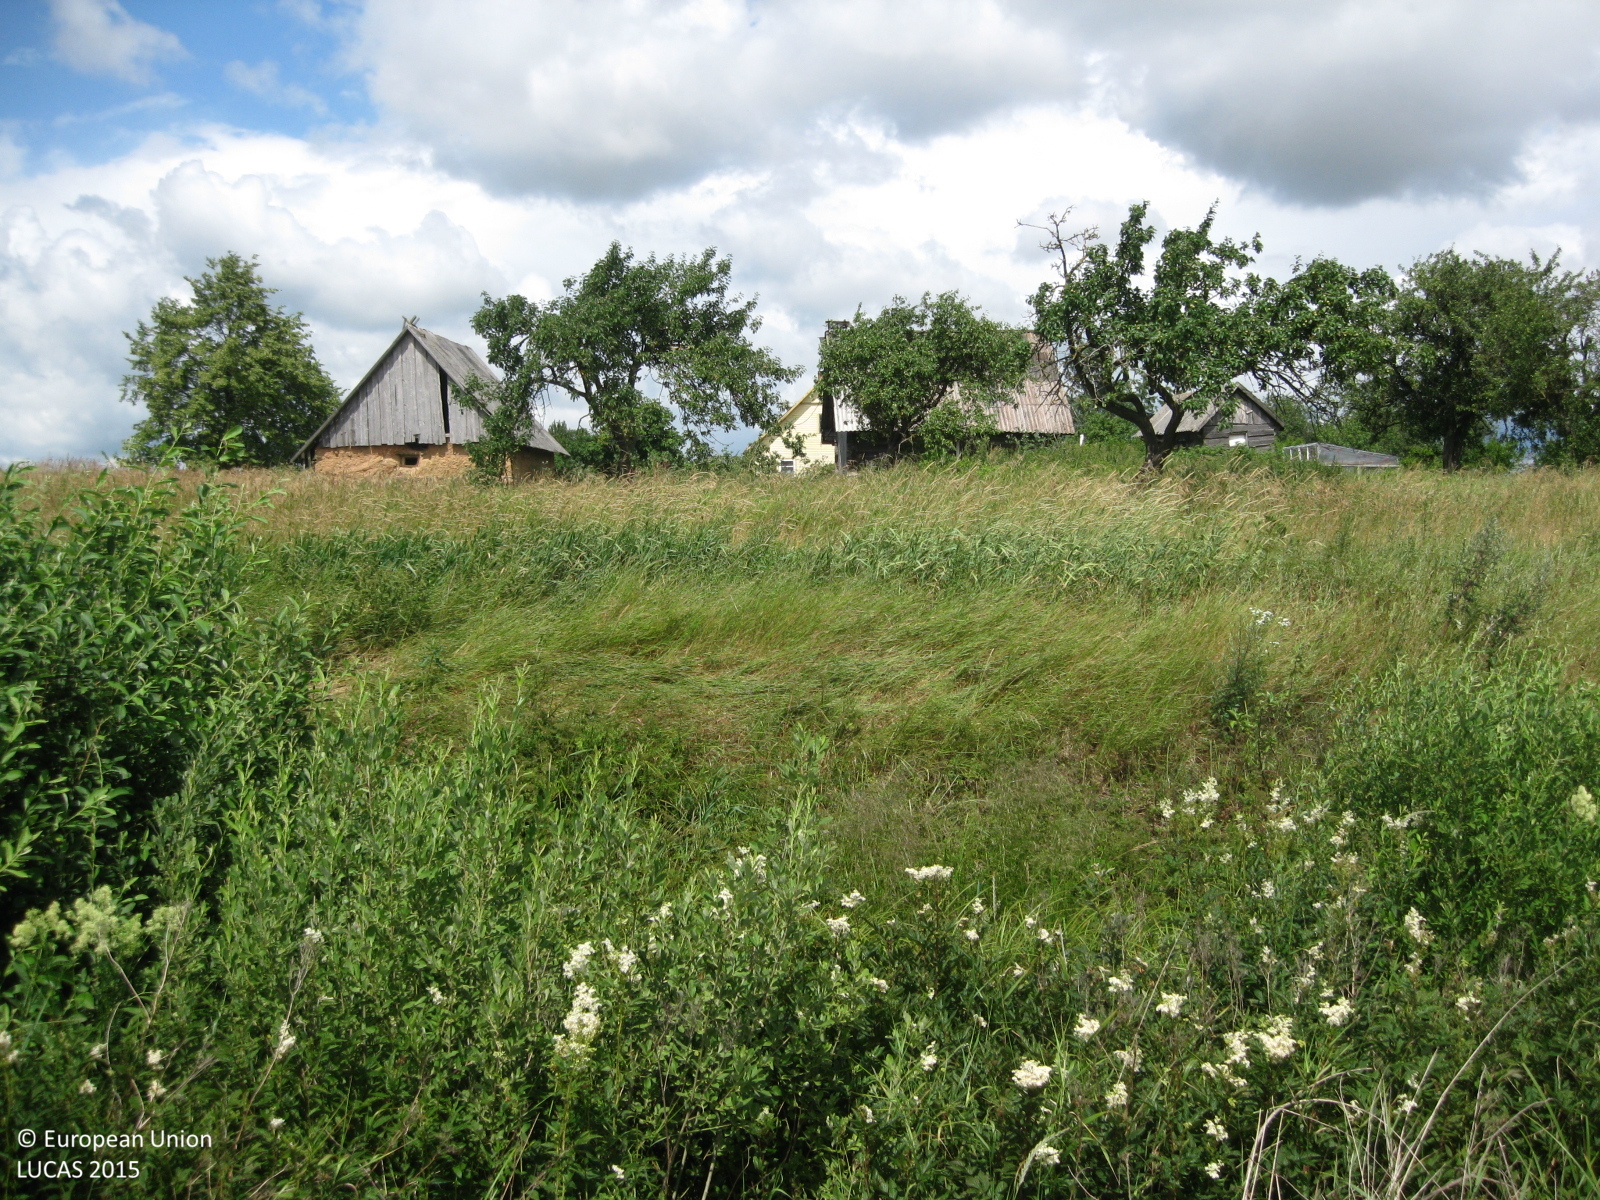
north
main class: Cropland
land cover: Dry pulses
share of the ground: > 75 %
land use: Agriculture (excluding fallow land and kitchen gardens)
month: July
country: LT
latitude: 55.6919
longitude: 24.3010
